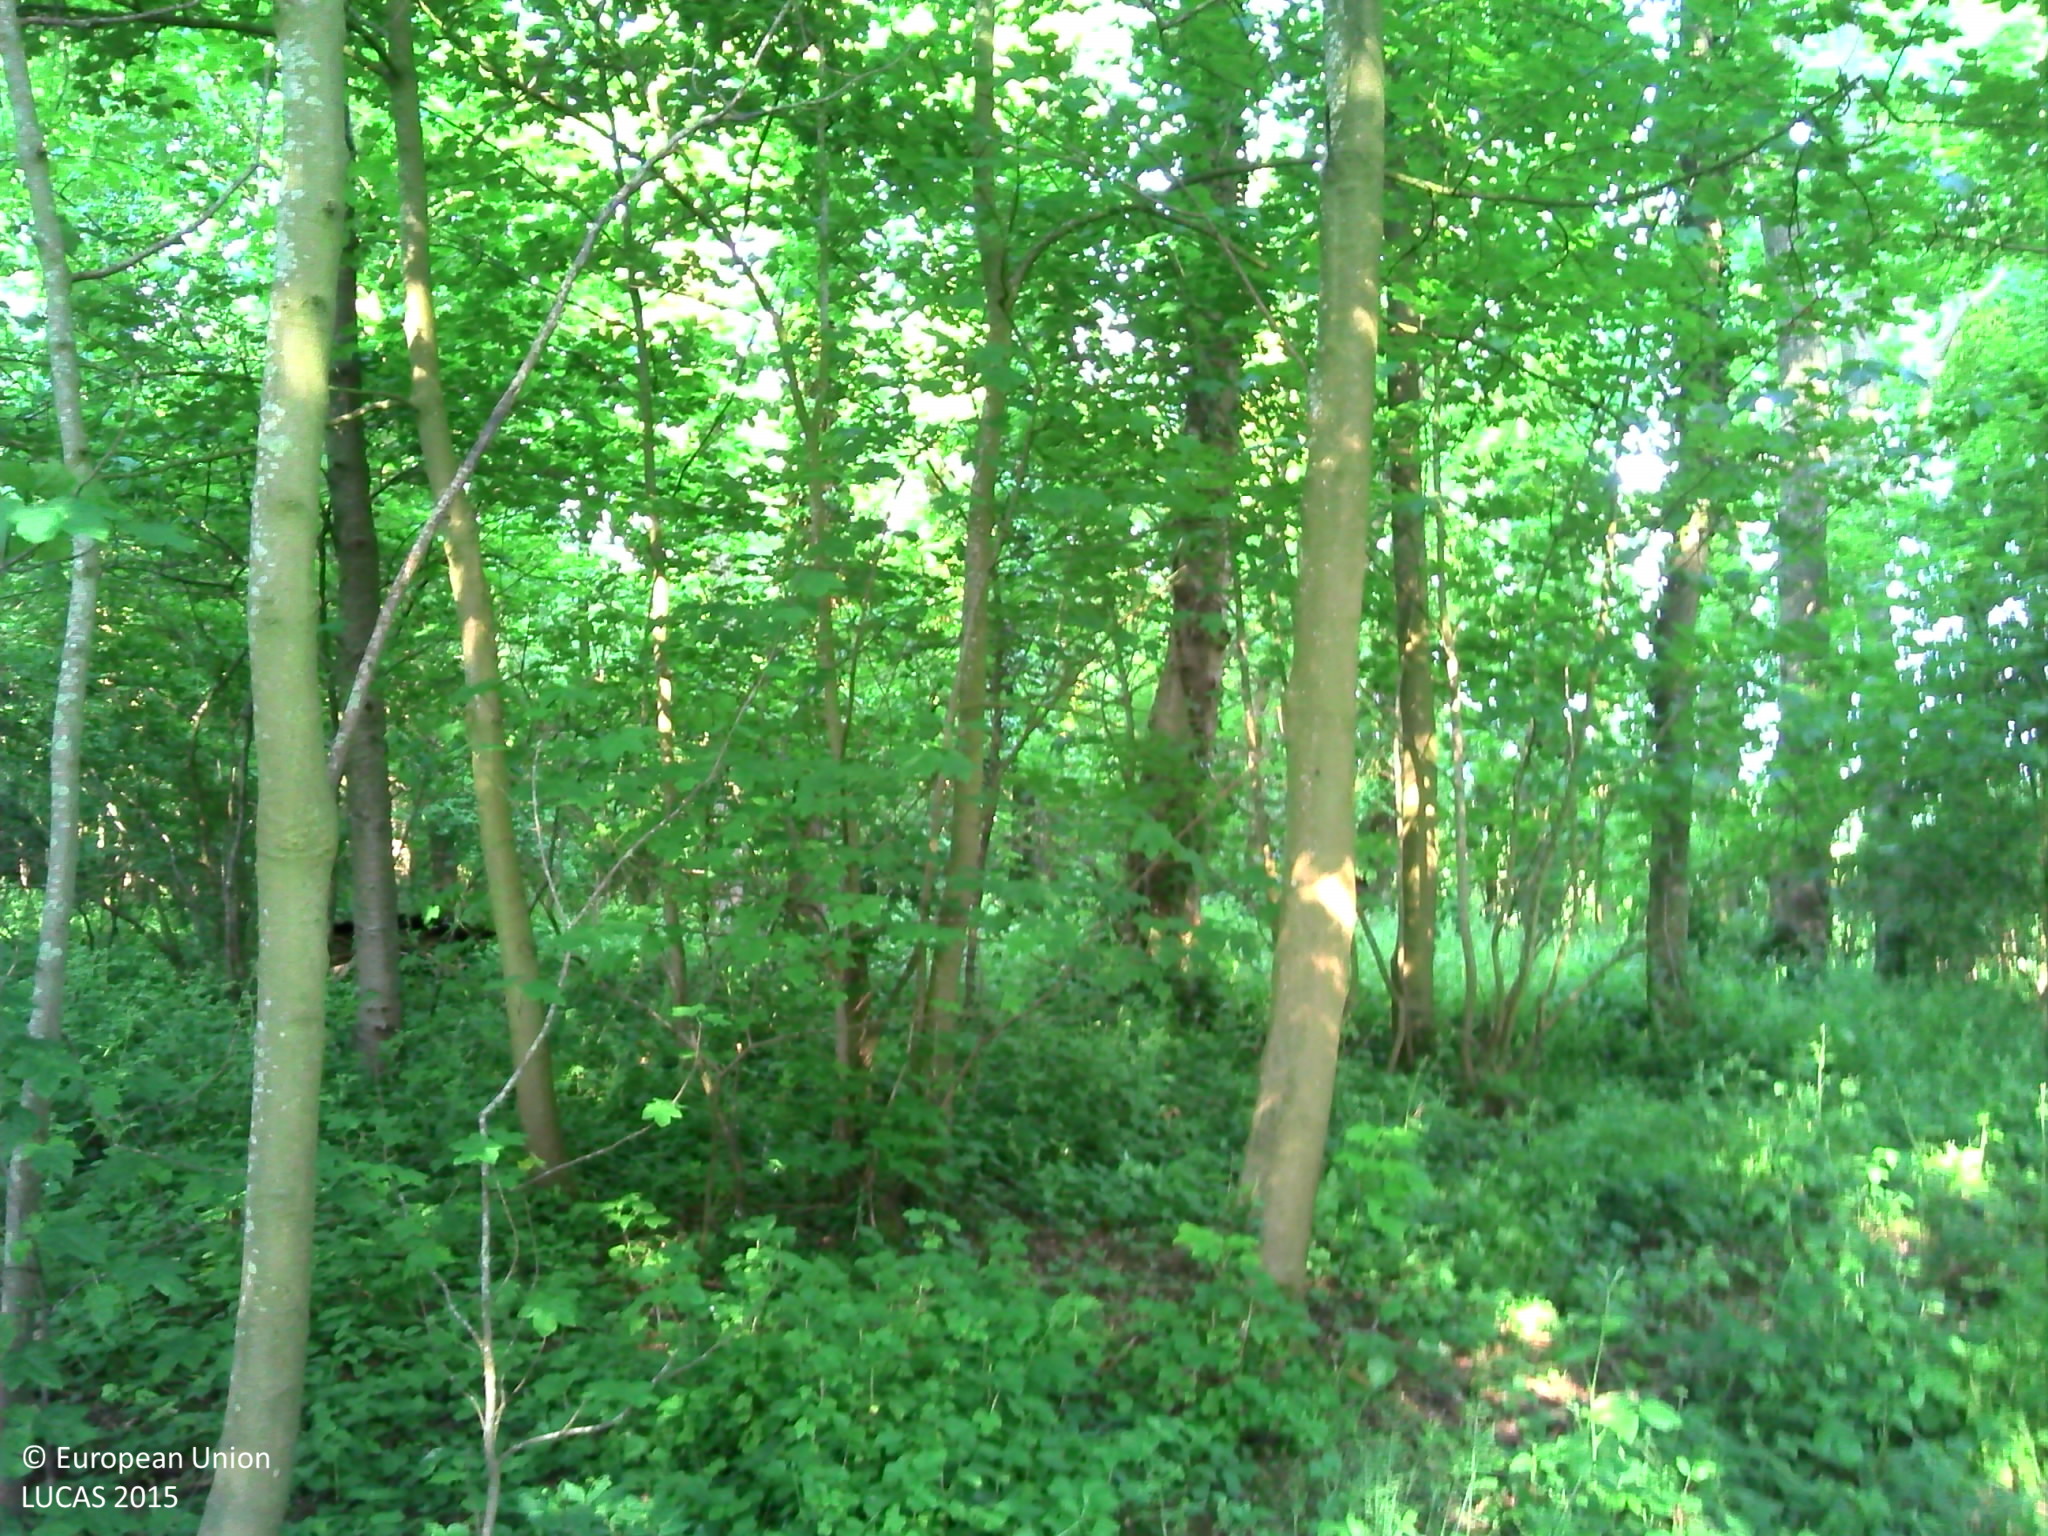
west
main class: Woodland
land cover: Broadleaved woodland
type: mesophytic deciduous forest
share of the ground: > 75 %
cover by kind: broadleaved forest trees 90 %, herbaceous plants 5 %
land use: Forestry
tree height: > 5 m
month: June
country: FR
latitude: 50.5401
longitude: 2.0688
